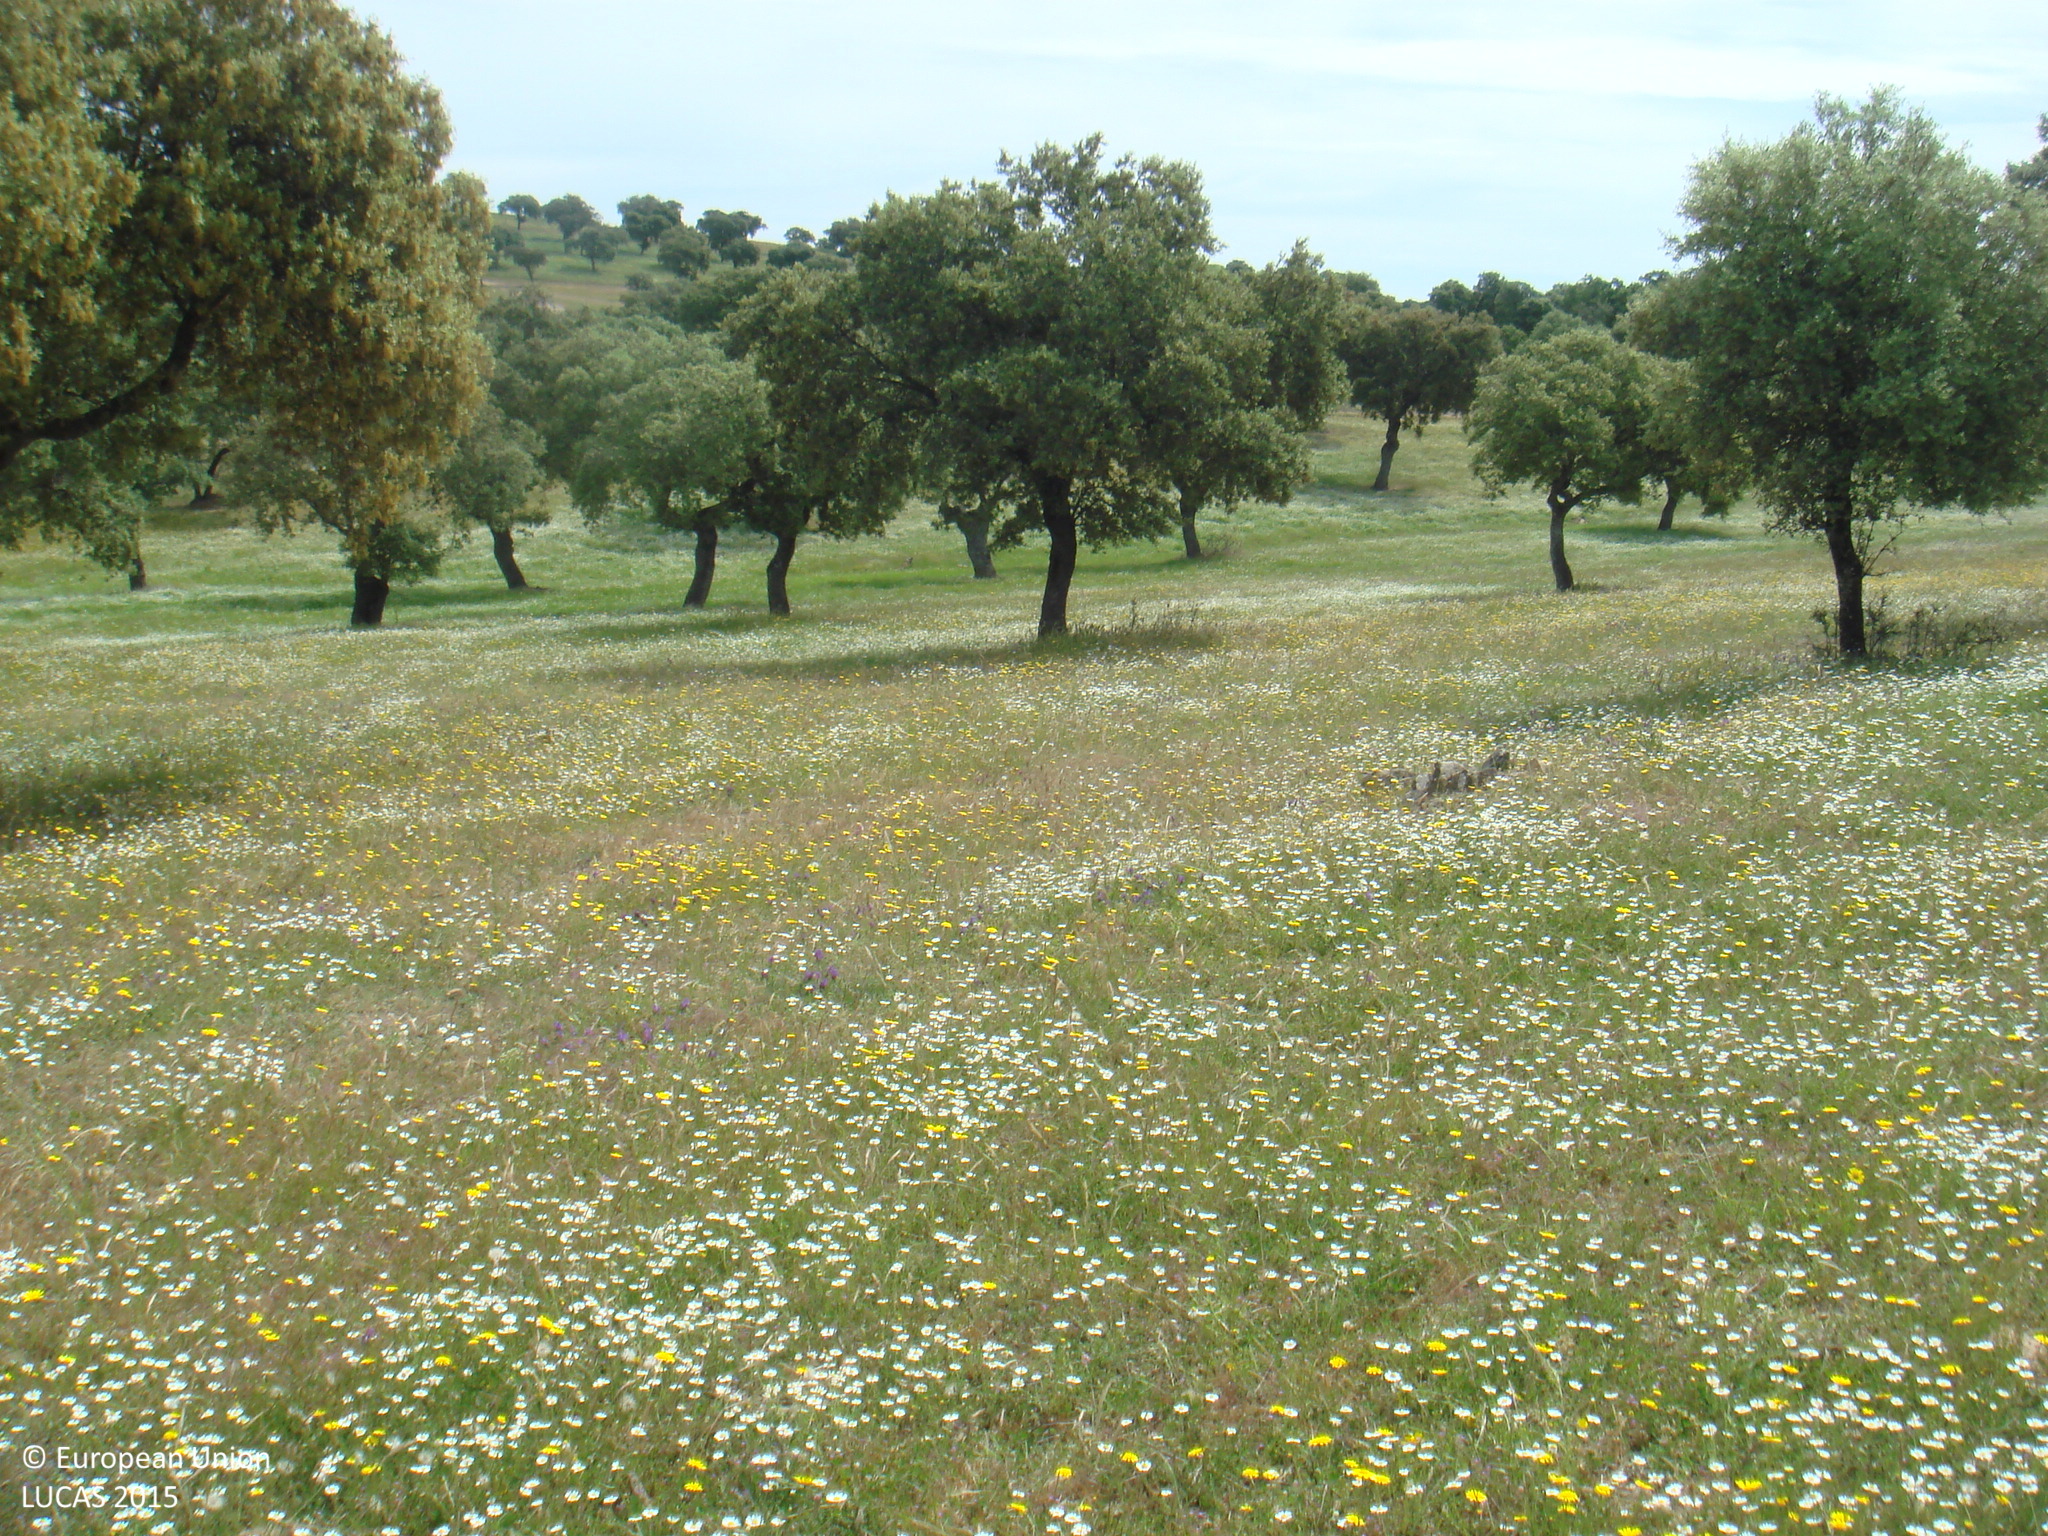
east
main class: Woodland
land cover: Broadleaved woodland
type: broadleaved evergreen forest
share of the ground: 25 - 50 %
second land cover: Grassland without tree/shrub cover
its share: > 75 %
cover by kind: herbaceous plants 70 %, broadleaved forest trees 30 %
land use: Forestry
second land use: Agriculture (excluding fallow land and kitchen gardens)
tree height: > 5 m
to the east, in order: Broadleaved woodland; Grassland without tree/shrub cover; Tracks; Broadleaved woodland; Fences; Tracks; Broadleaved woodland
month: May
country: ES
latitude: 38.3775
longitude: -5.0796
